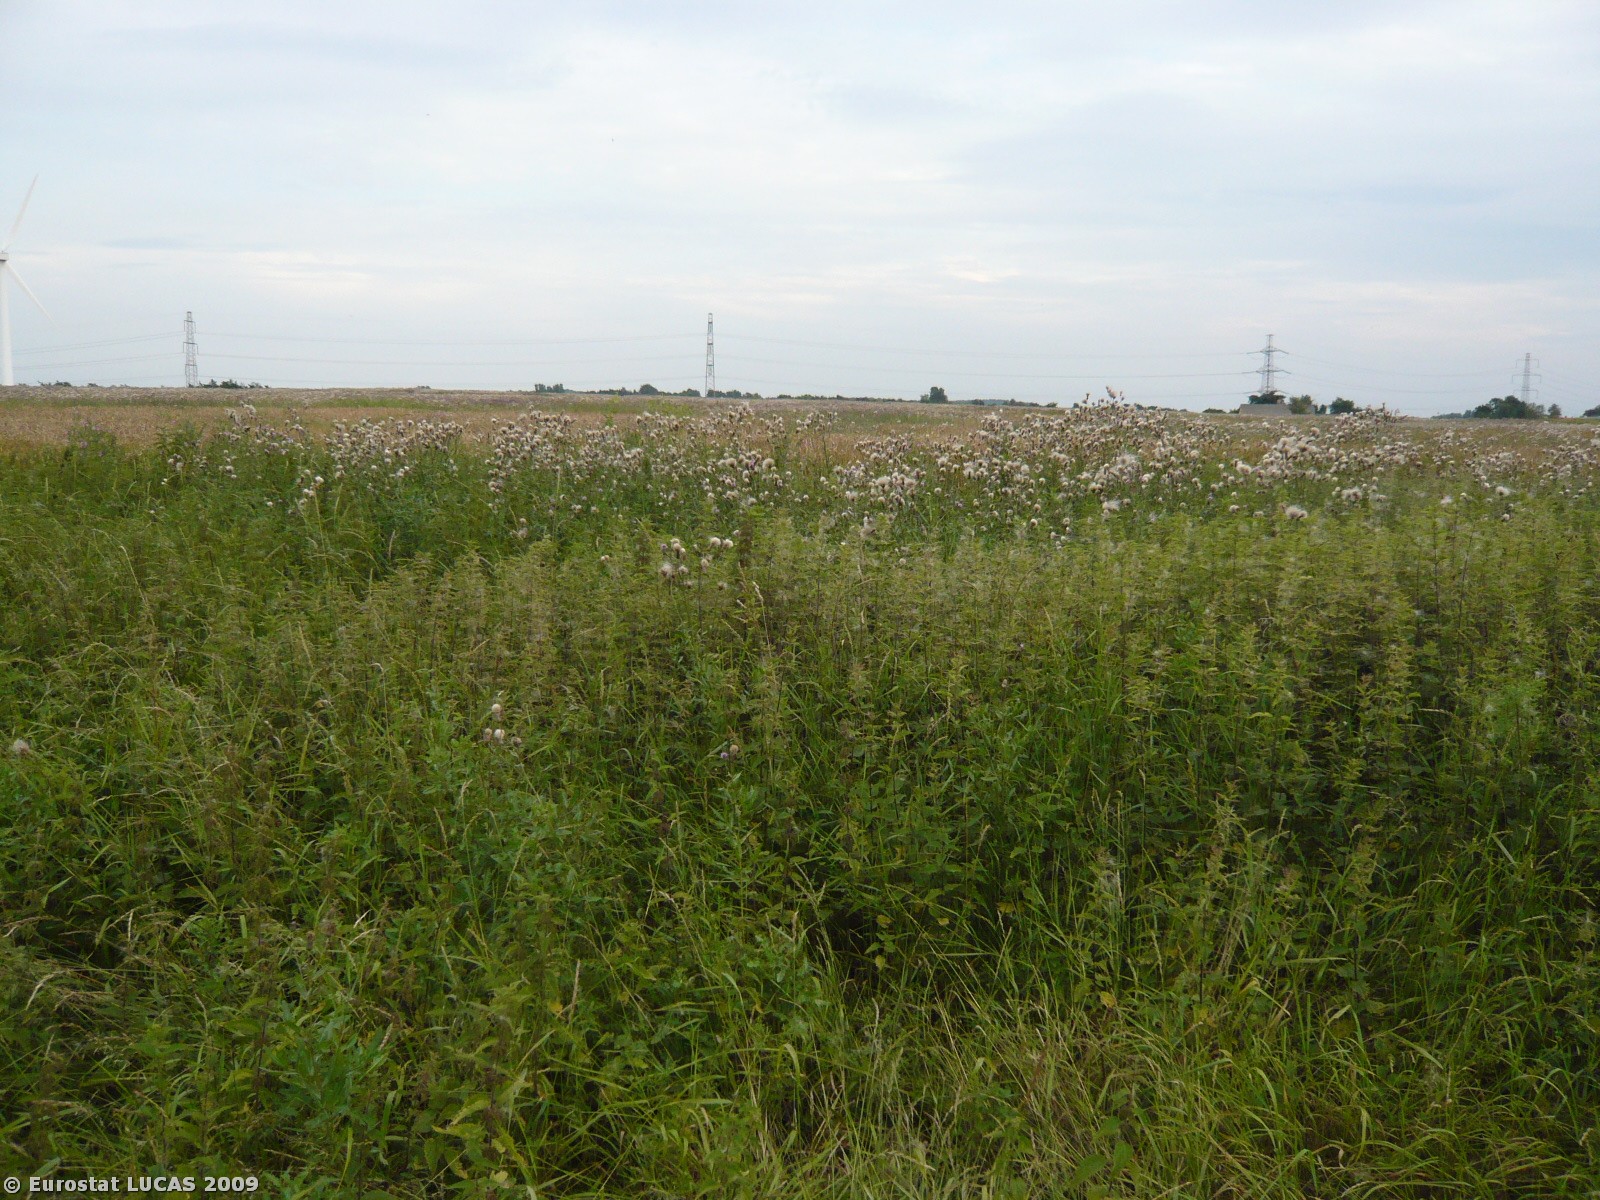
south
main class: Grassland
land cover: Spontaneously vegetated surfaces
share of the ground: > 75 %
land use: Residential
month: July
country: DK
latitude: 55.8994
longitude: 12.1890
